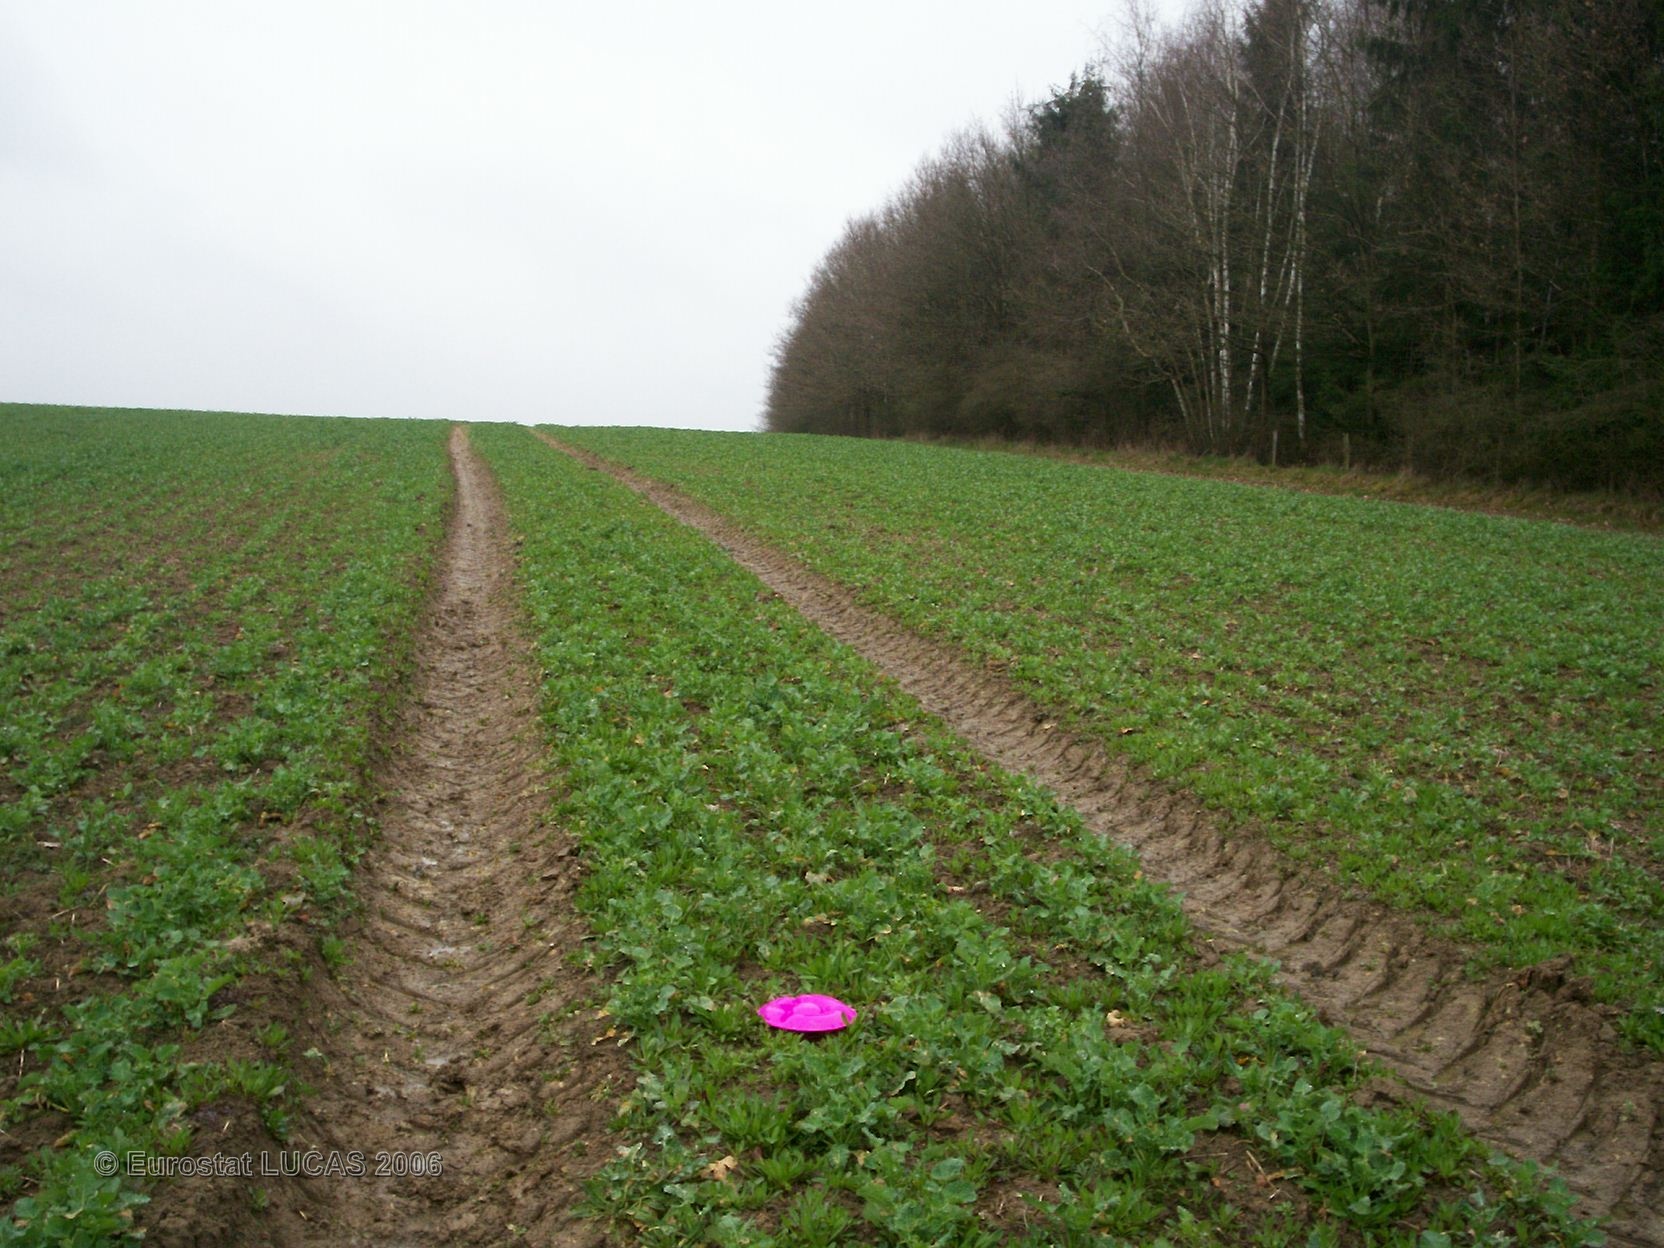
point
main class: Cropland
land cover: Rape and turnip rape
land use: Agriculture (excluding fallow land and kitchen gardens)
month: April
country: FR
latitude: 48.6628
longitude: 6.7827
